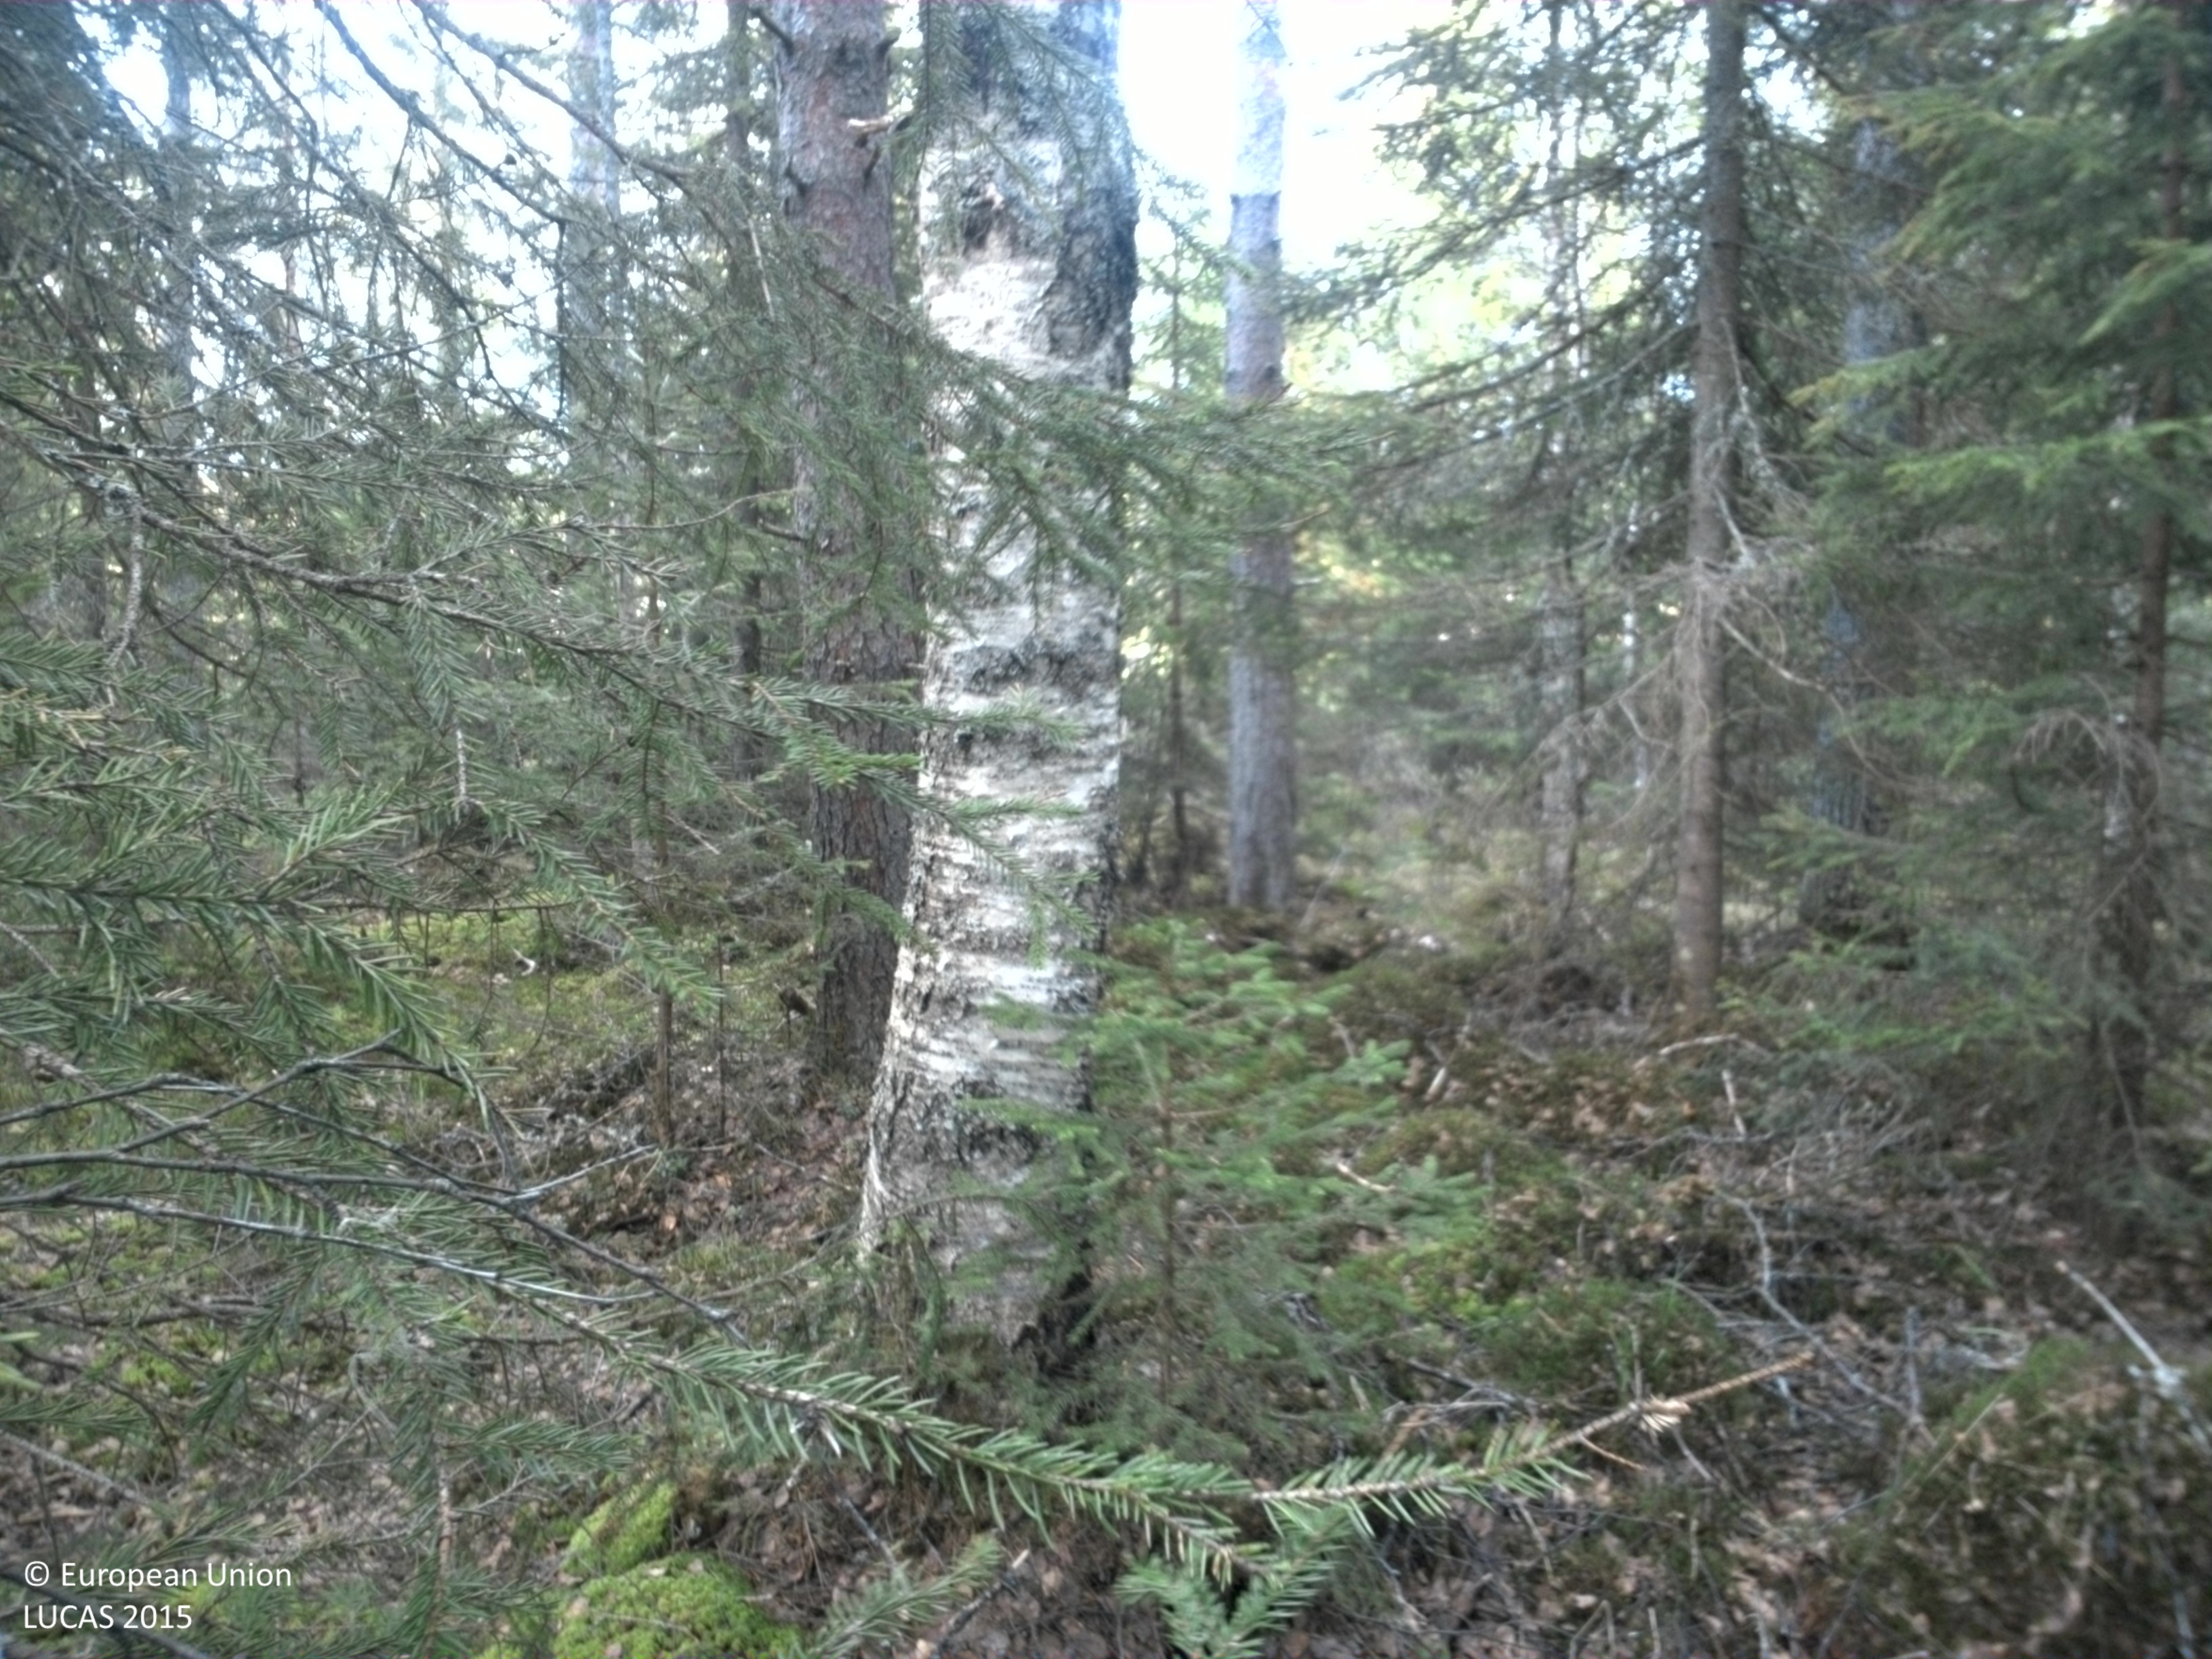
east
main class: Woodland
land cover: Spruce dominated mixed woodland
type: boreal forest
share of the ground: > 75 %
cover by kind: coniferous forest trees 60 %, broadleaved forest trees 20 %, herbaceous plants 10 %, lichens and mosses 10 %
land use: Semi-natural and natural areas not in use
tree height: > 5 m
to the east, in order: Spruce dominated mixed woodland; Ditches and canals; Temporary grasslands; Abandoned hedges; Temporary grasslands; Inland fresh running water; Abandoned hedges; Fences; Abandoned hedges; Temporary grasslands
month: June
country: SE
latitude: 61.1338
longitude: 13.2755
